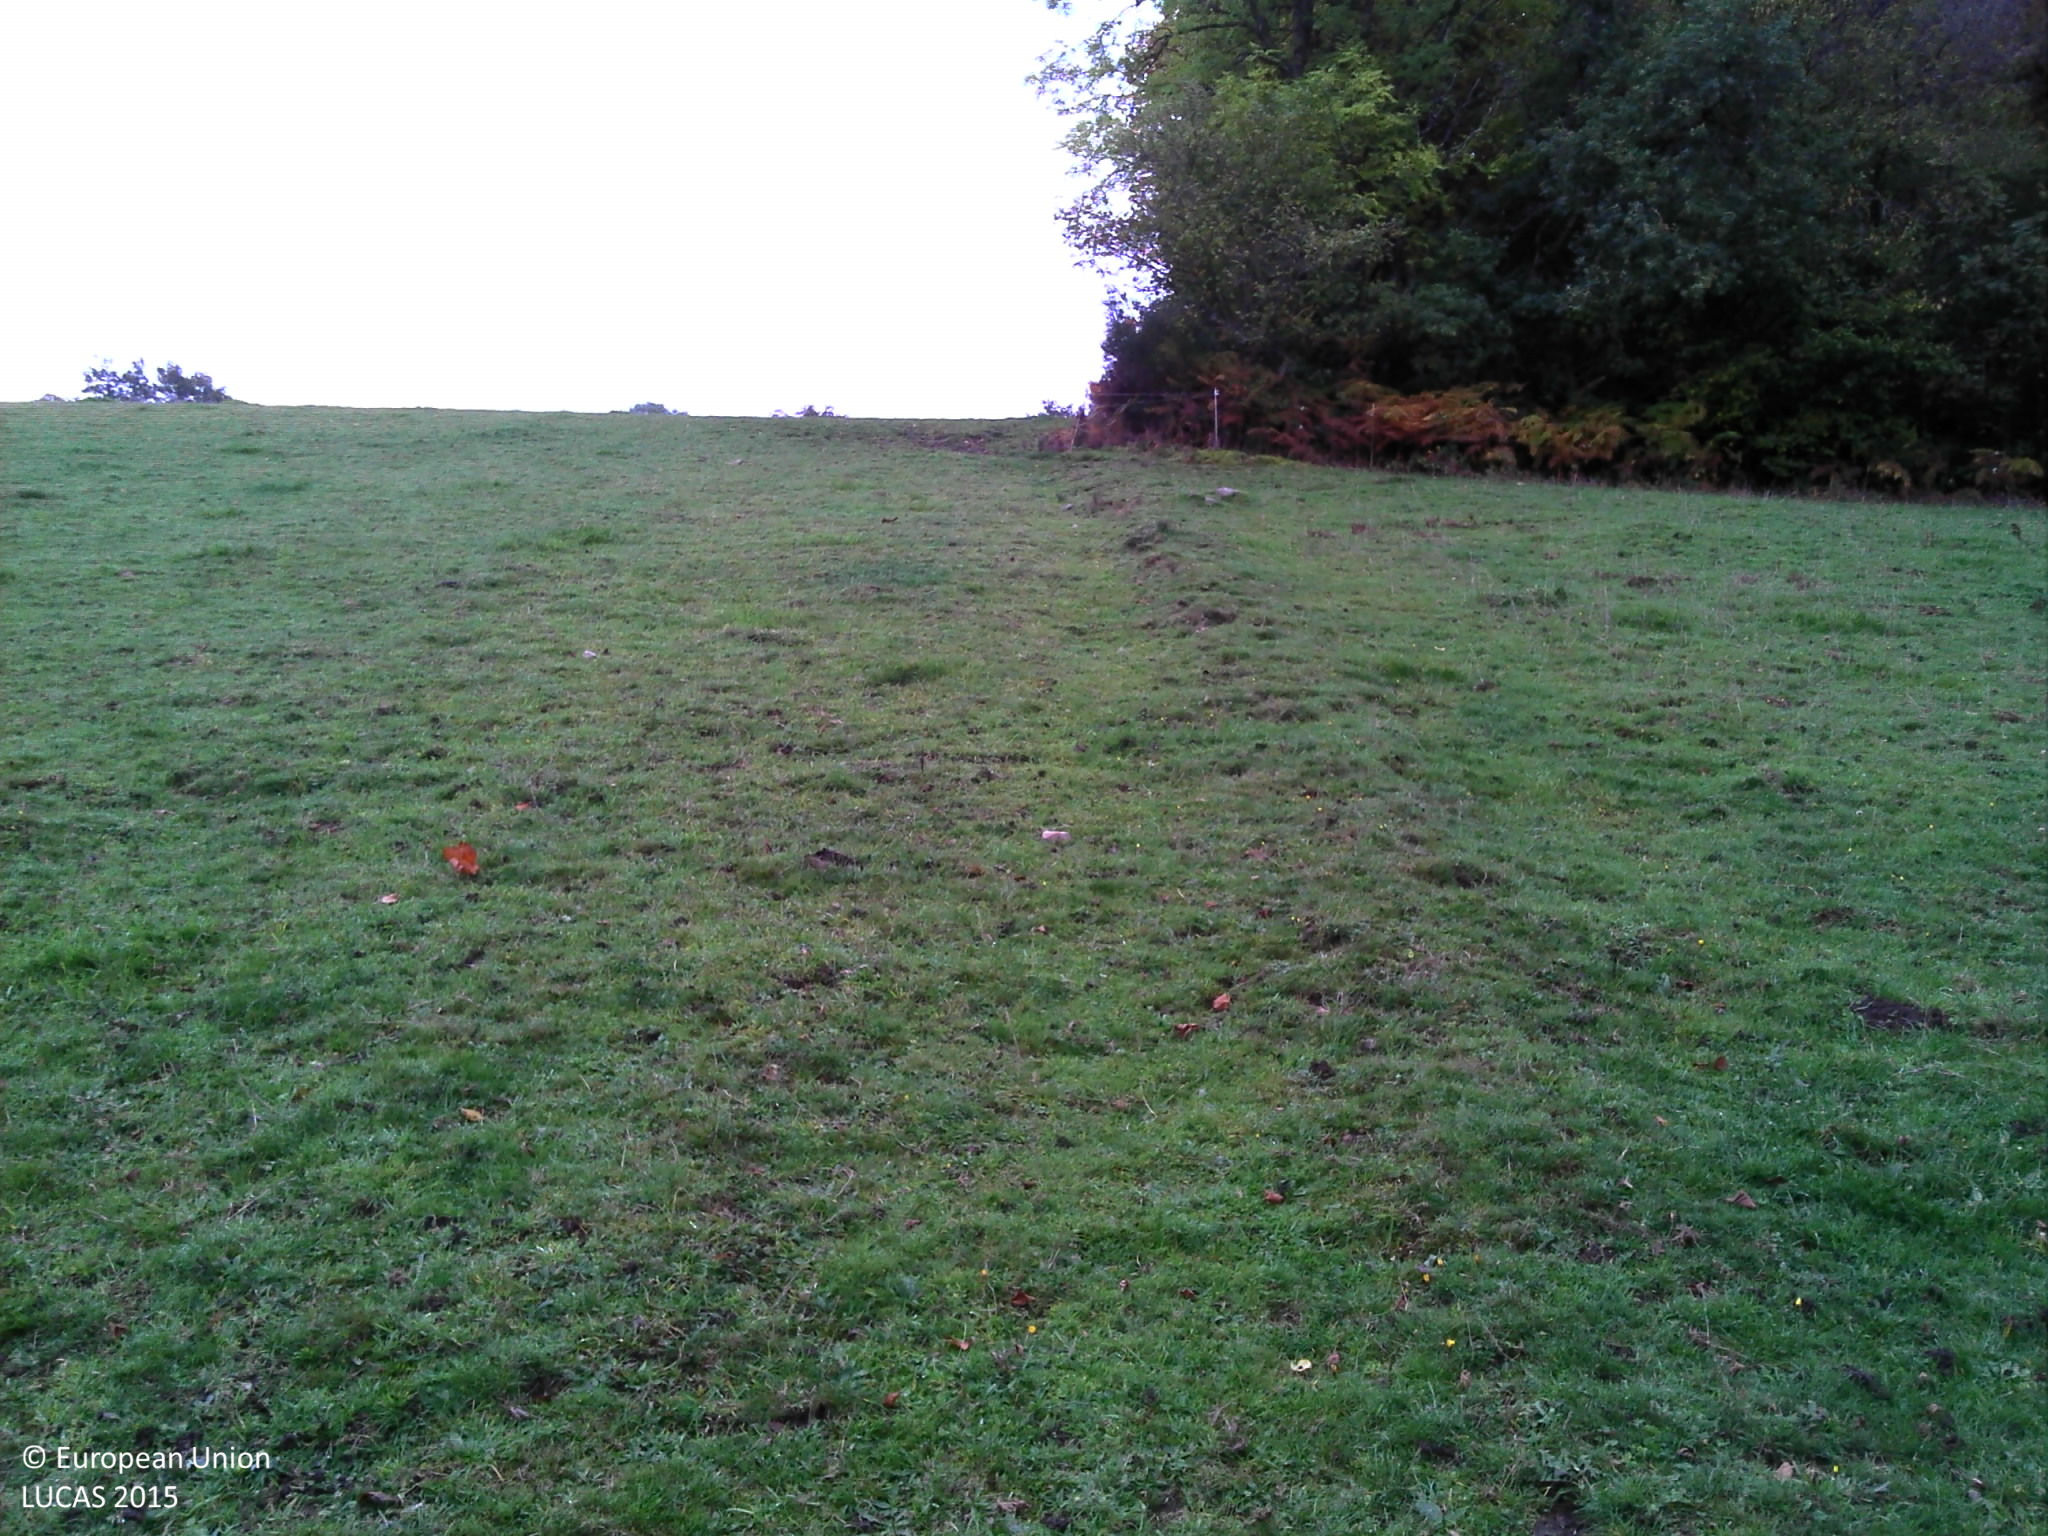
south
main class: Grassland
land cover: Grassland without tree/shrub cover
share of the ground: > 75 %
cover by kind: herbaceous plants 90 %, unconsolidated bare surface 10 %
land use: Agriculture (excluding fallow land and kitchen gardens)
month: October
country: FR
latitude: 46.0217
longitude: 2.8547
